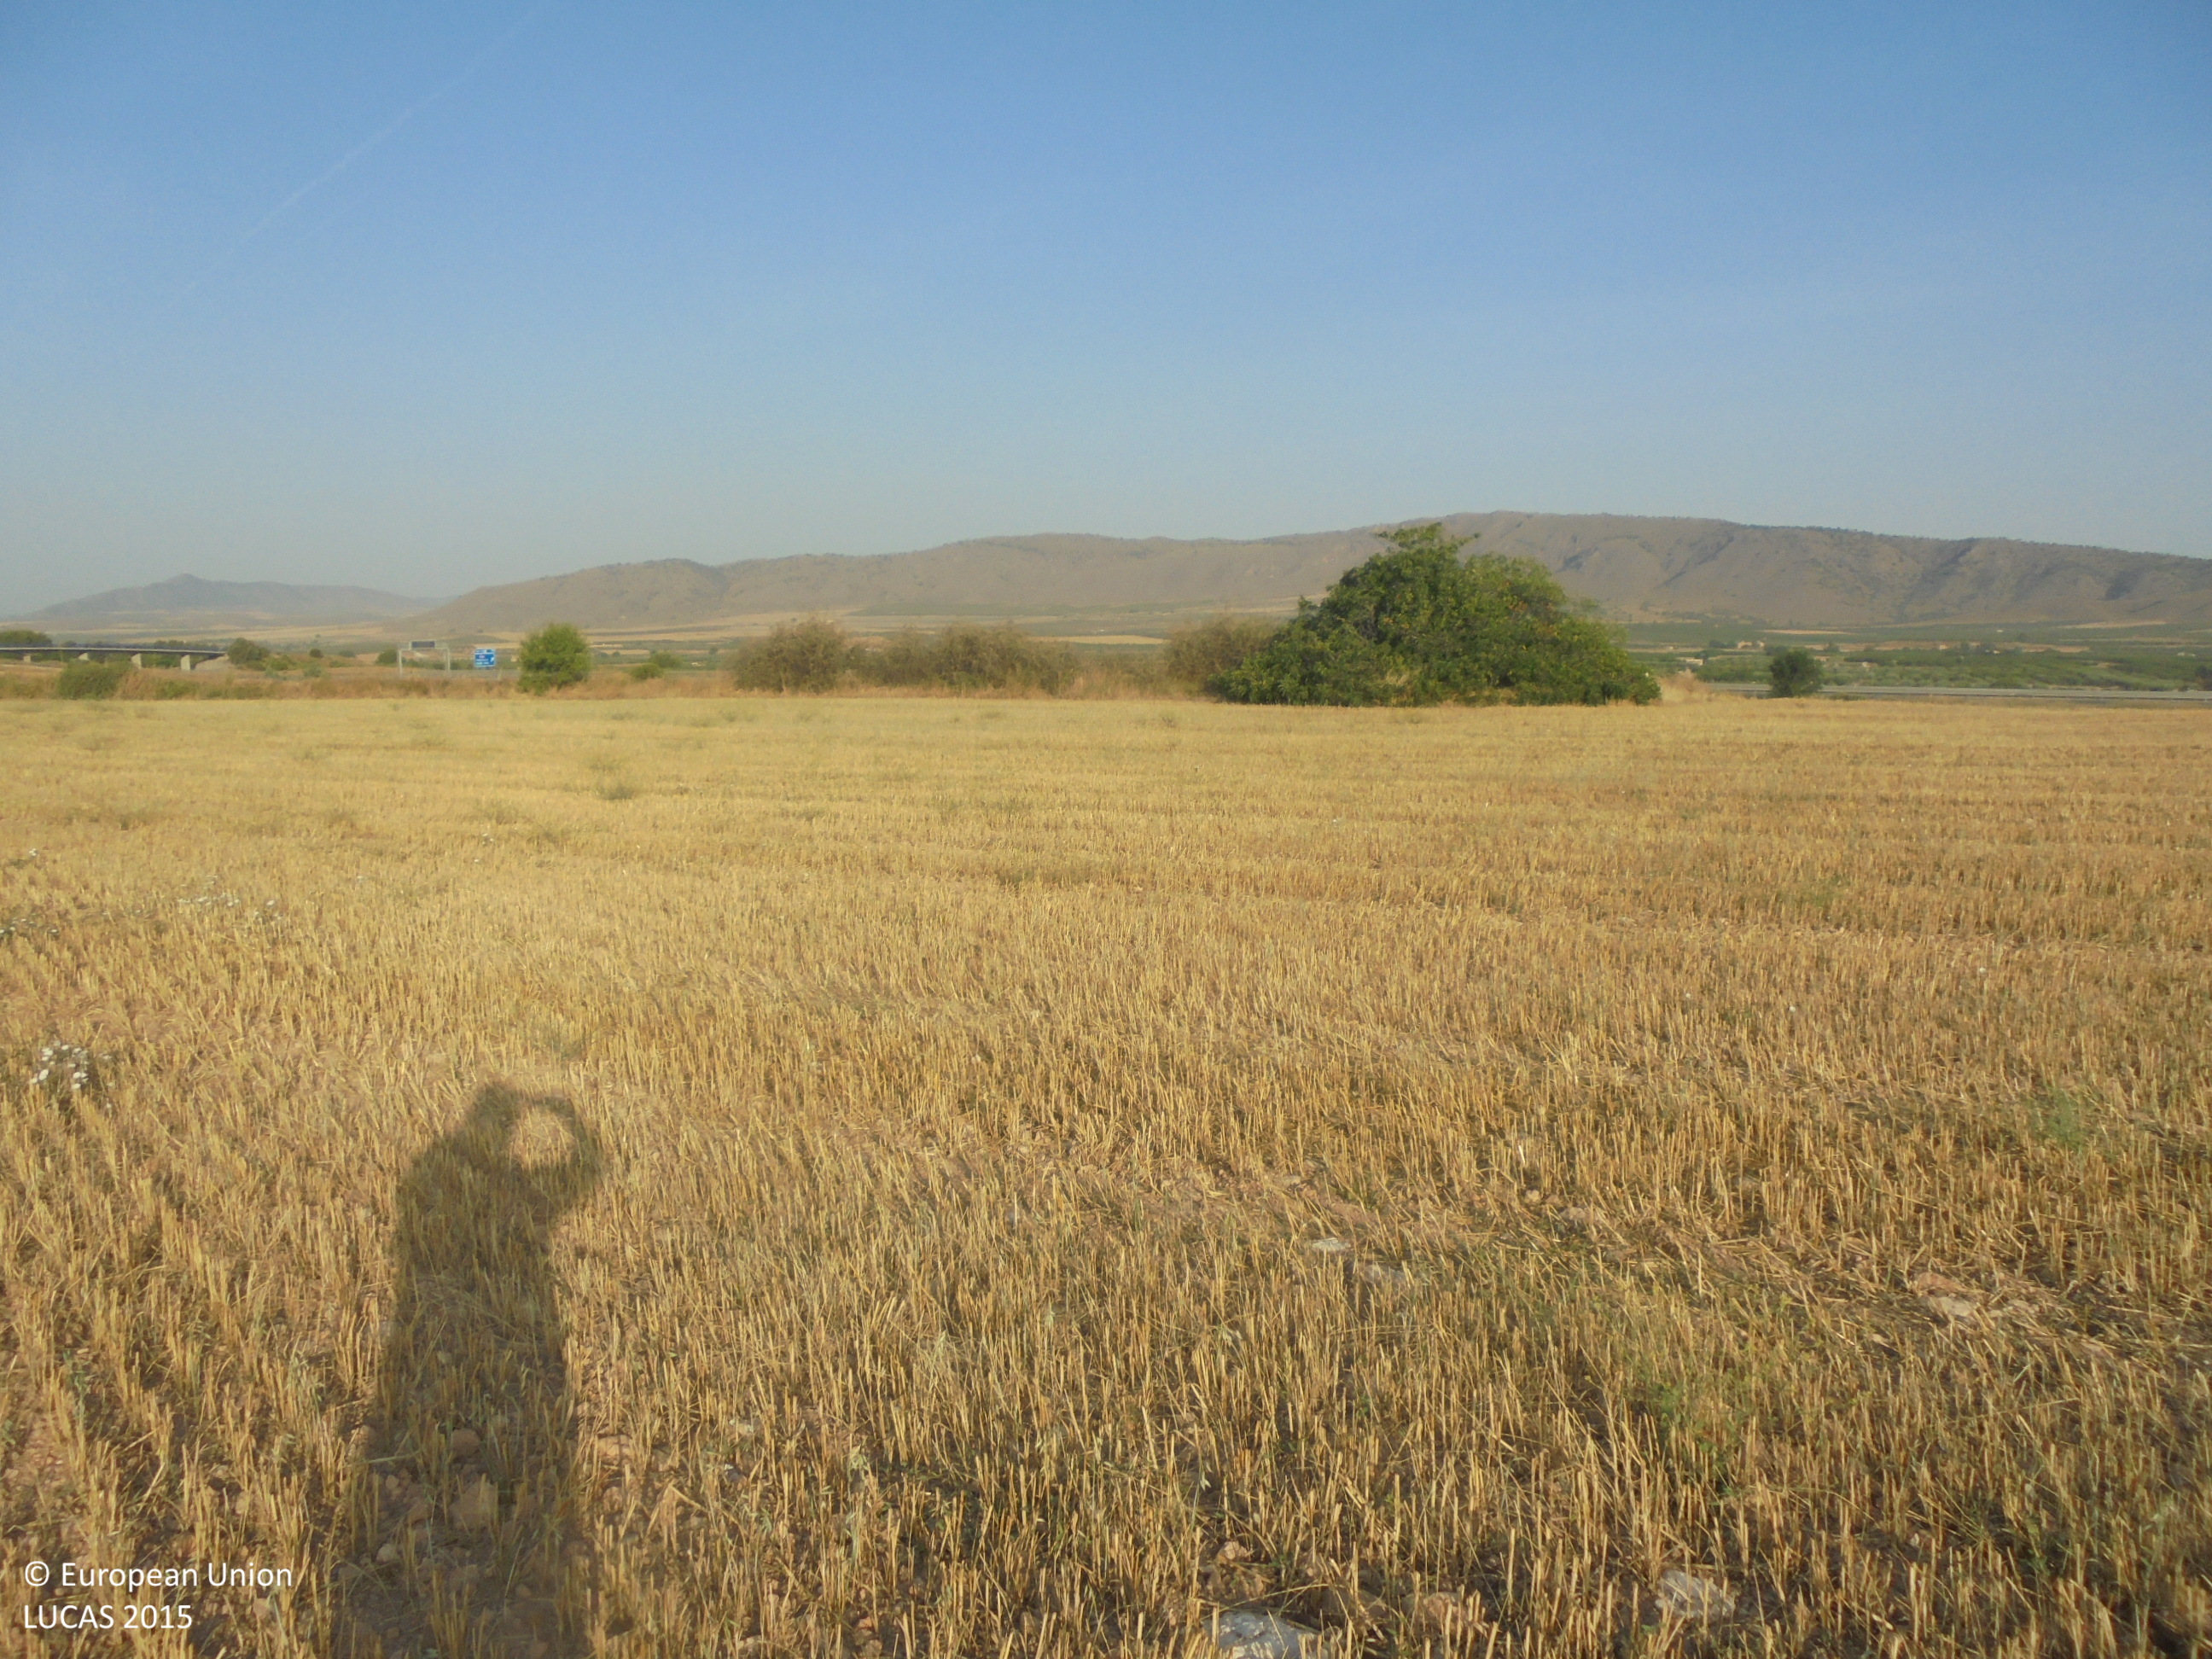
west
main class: Cropland
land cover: Oats
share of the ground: < 10 %
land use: Agriculture (excluding fallow land and kitchen gardens)
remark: Harvested field
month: July
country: ES
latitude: 38.6175
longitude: -1.6749
